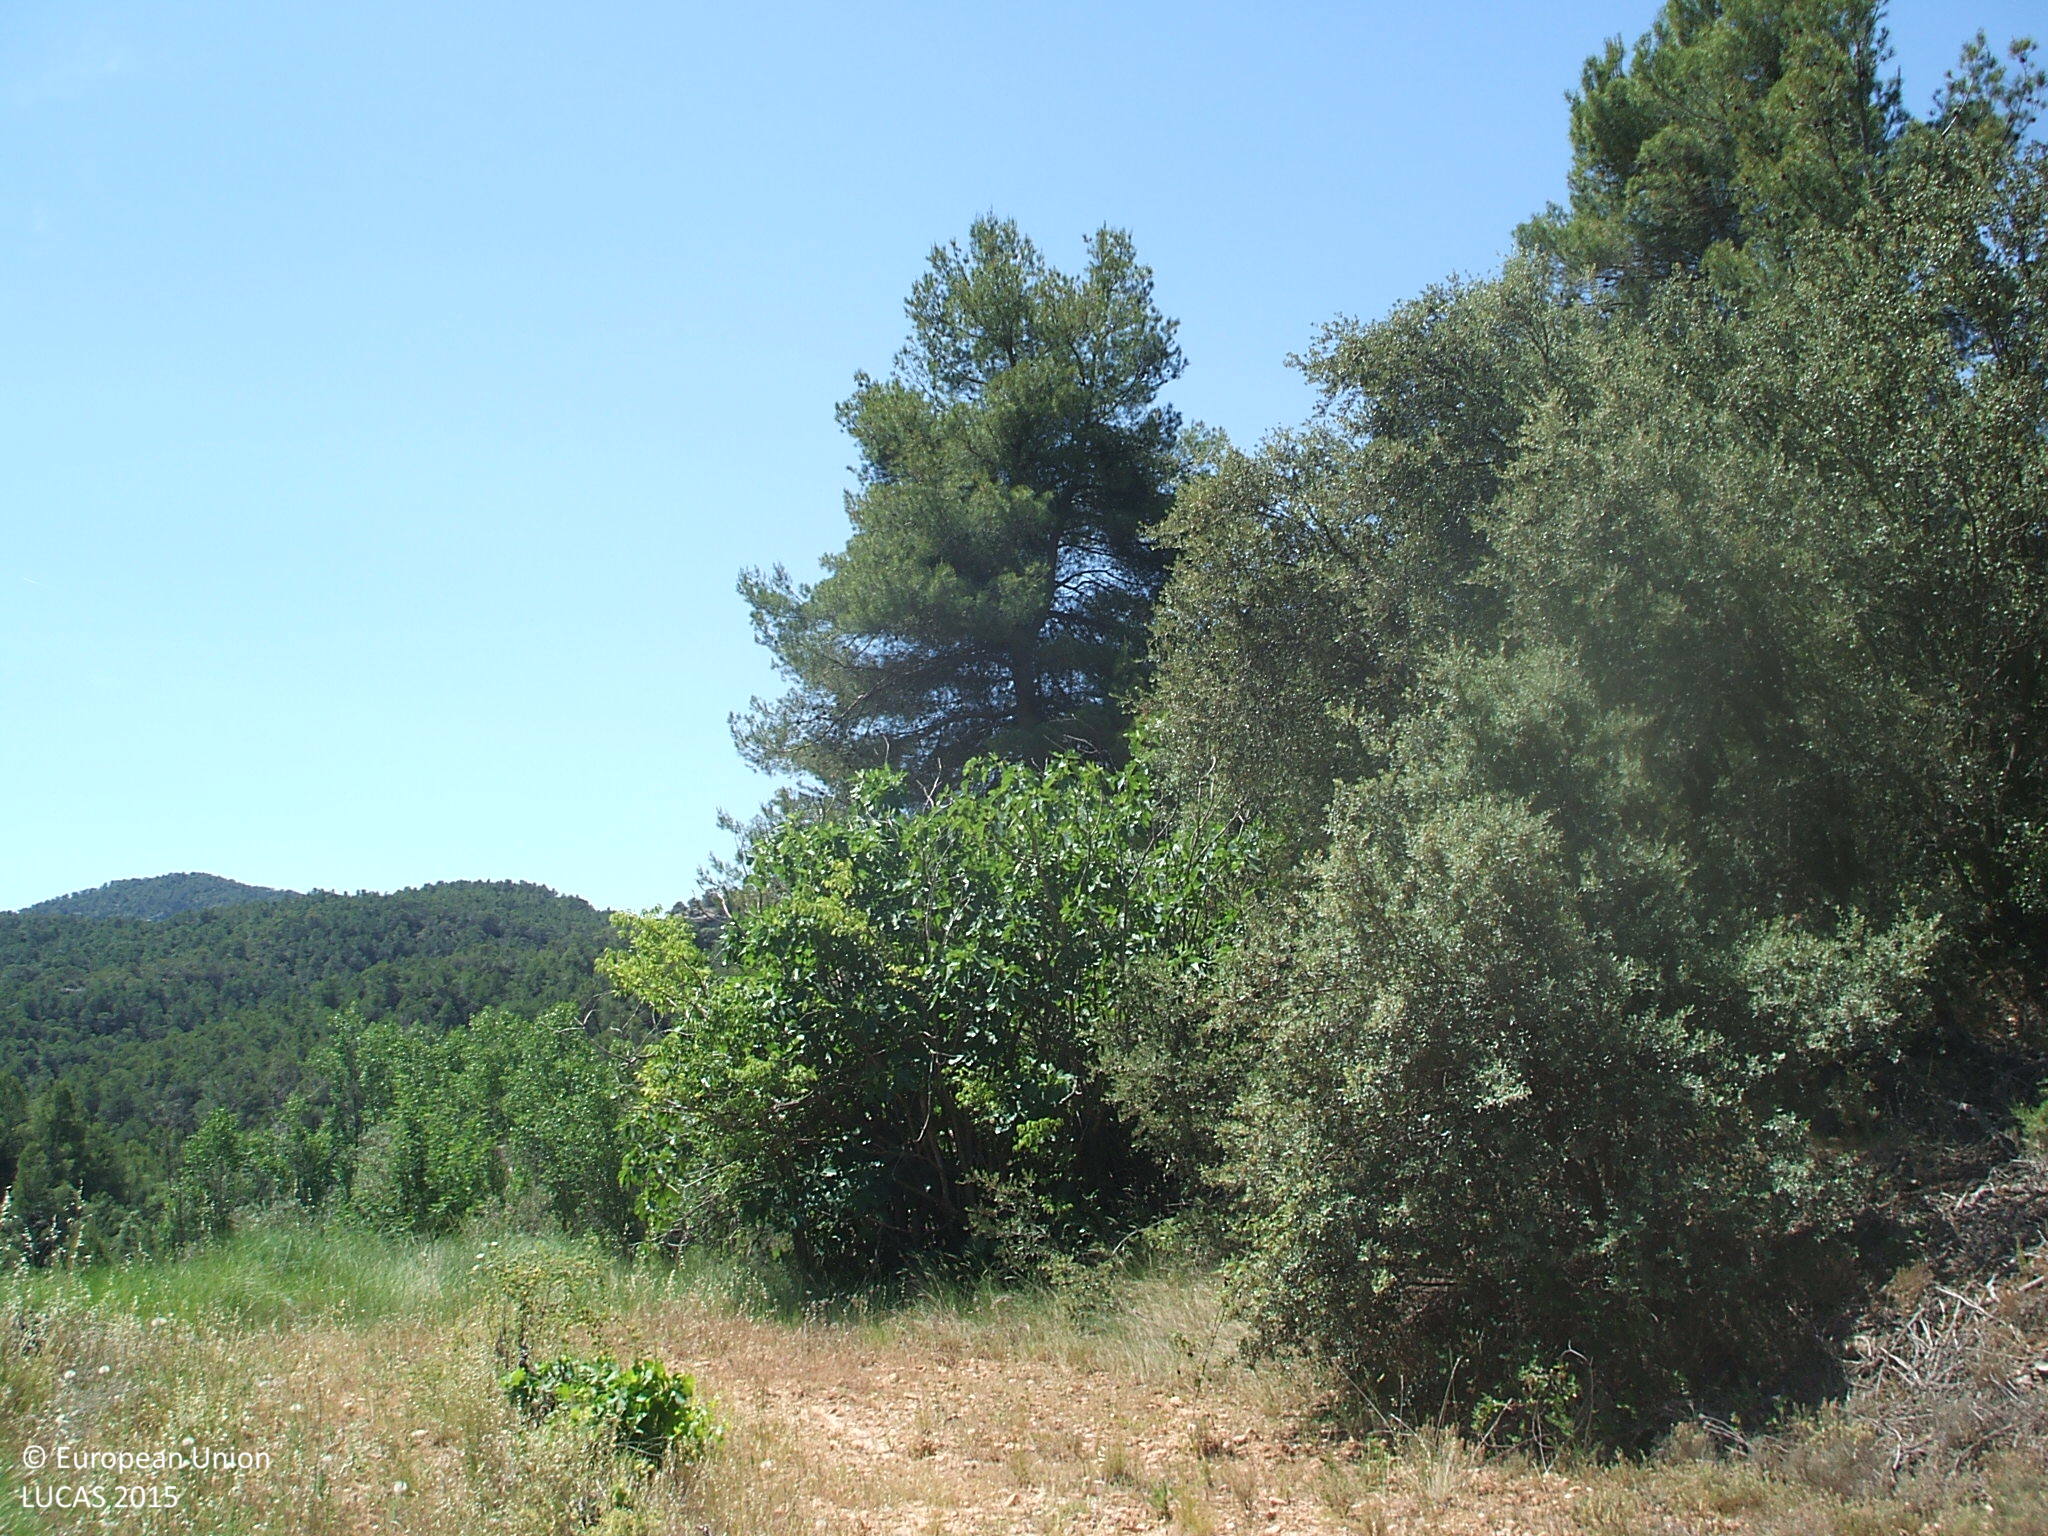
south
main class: Woodland
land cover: Pine dominated mixed woodland
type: coniferous forest of the mediterranean region
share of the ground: 50 - 75 %
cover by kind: shrubs 50 %, coniferous forest trees 25 %, broadleaved forest trees 25 %
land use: Semi-natural and natural areas not in use
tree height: > 5 m
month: June
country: ES
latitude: 40.8471
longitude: -0.0078
